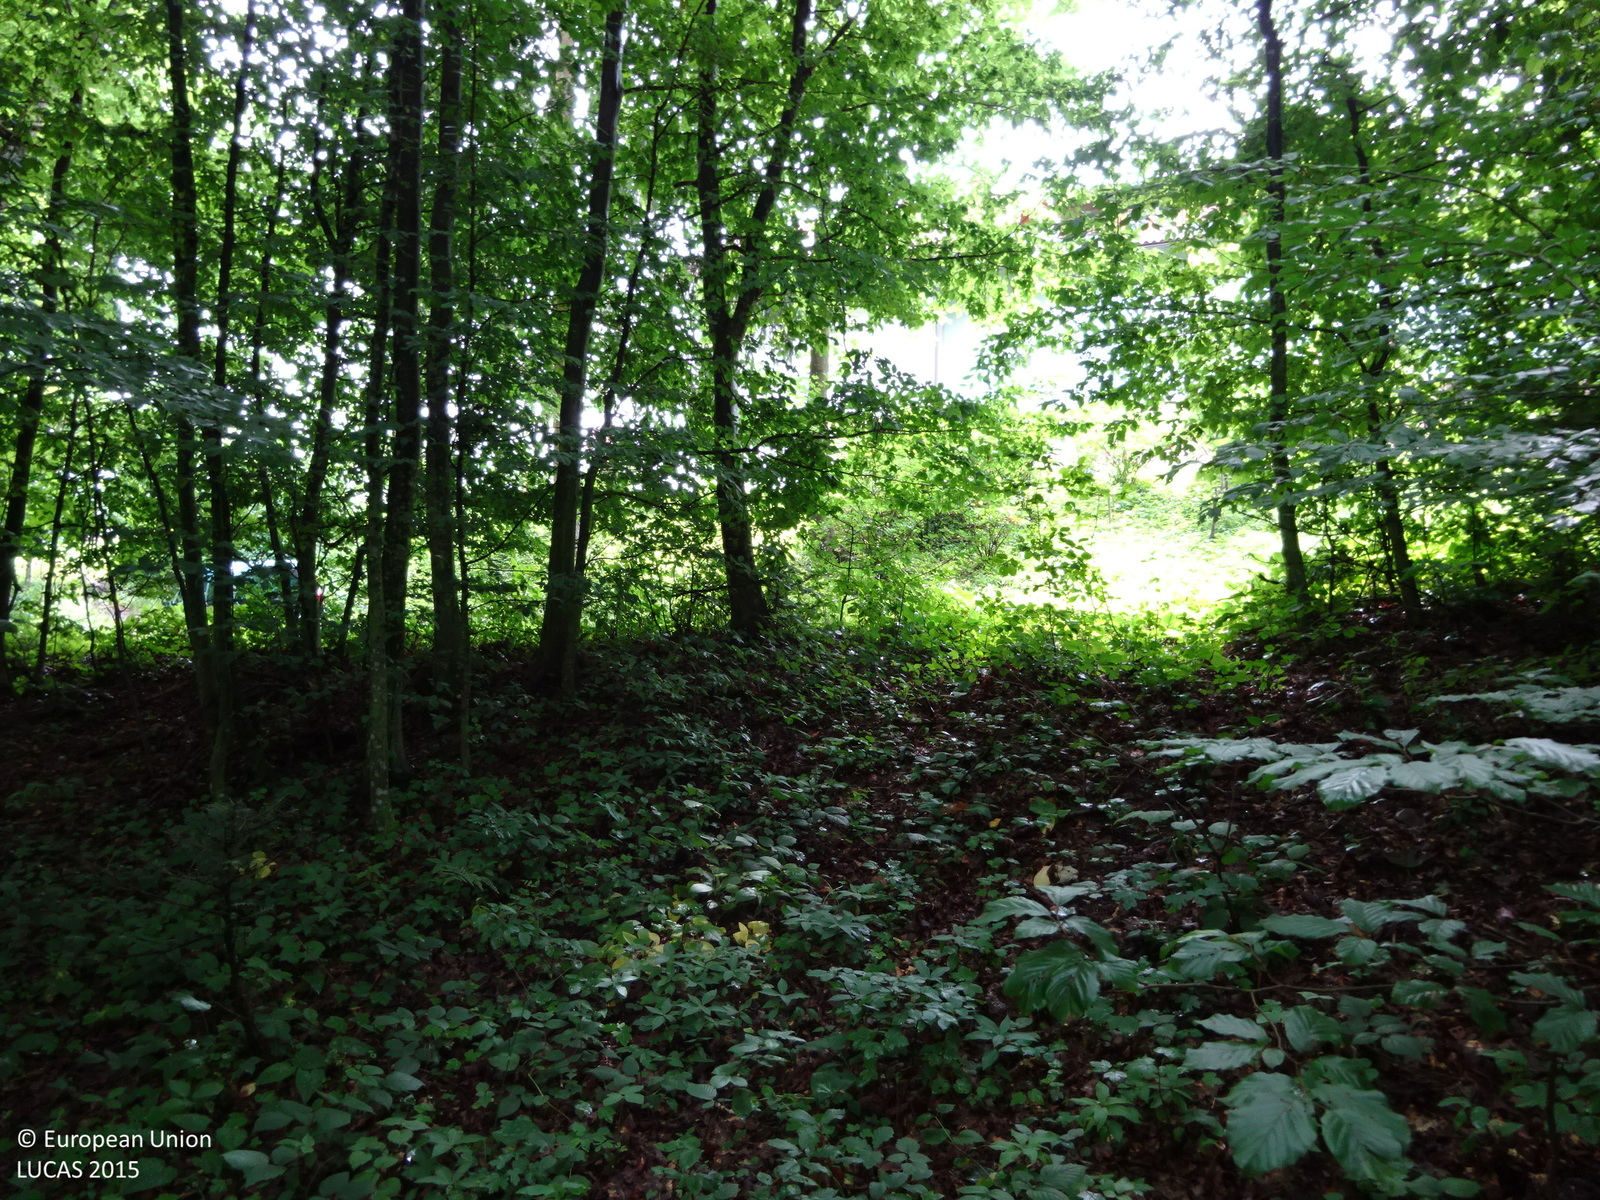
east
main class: Woodland
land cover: Broadleaved woodland
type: mountainous beech forest
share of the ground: > 75 %
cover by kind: broadleaved forest trees 80 %, coniferous forest trees 10 %, herbaceous plants 10 %
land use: Forestry
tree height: > 5 m
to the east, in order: Broadleaved woodland; Grass margins; Paved roads, cycling and walking lanes; Shrubland with sparse tree cover; Fences; Other fresh vegetables; Fences; Grassland without tree/shrub cover; Broadleaved woodland; Tracks; Broadleaved woodland; Spruce dominated coniferous woodland; Fences; Grassland with sparse tree/shrub cover; Fences; Other fresh vegetables; Fences; Grassland without tree/shrub cover; Grassland with sparse tree/shrub cover
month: June
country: AT
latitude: 46.6662
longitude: 15.3968
